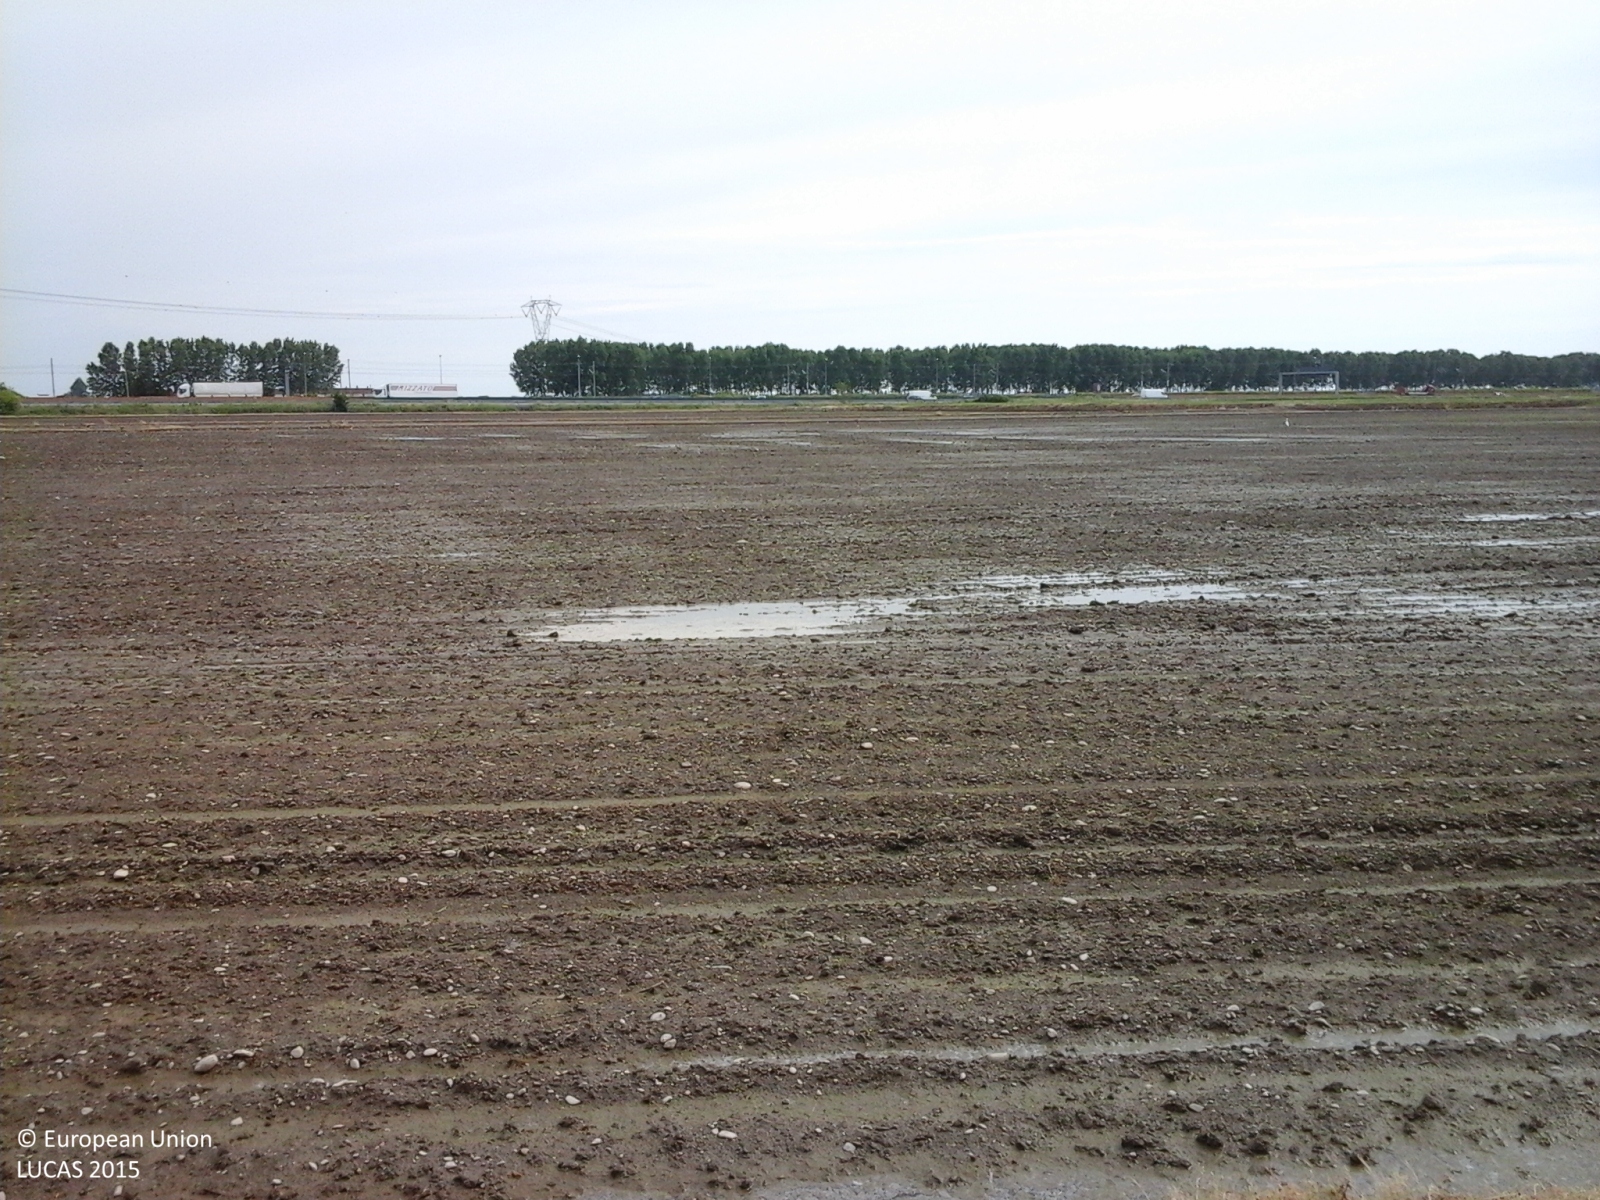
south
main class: Cropland
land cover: Rice
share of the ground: < 10 %
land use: Agriculture (excluding fallow land and kitchen gardens)
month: May
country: IT
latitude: 45.4765
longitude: 8.5569
